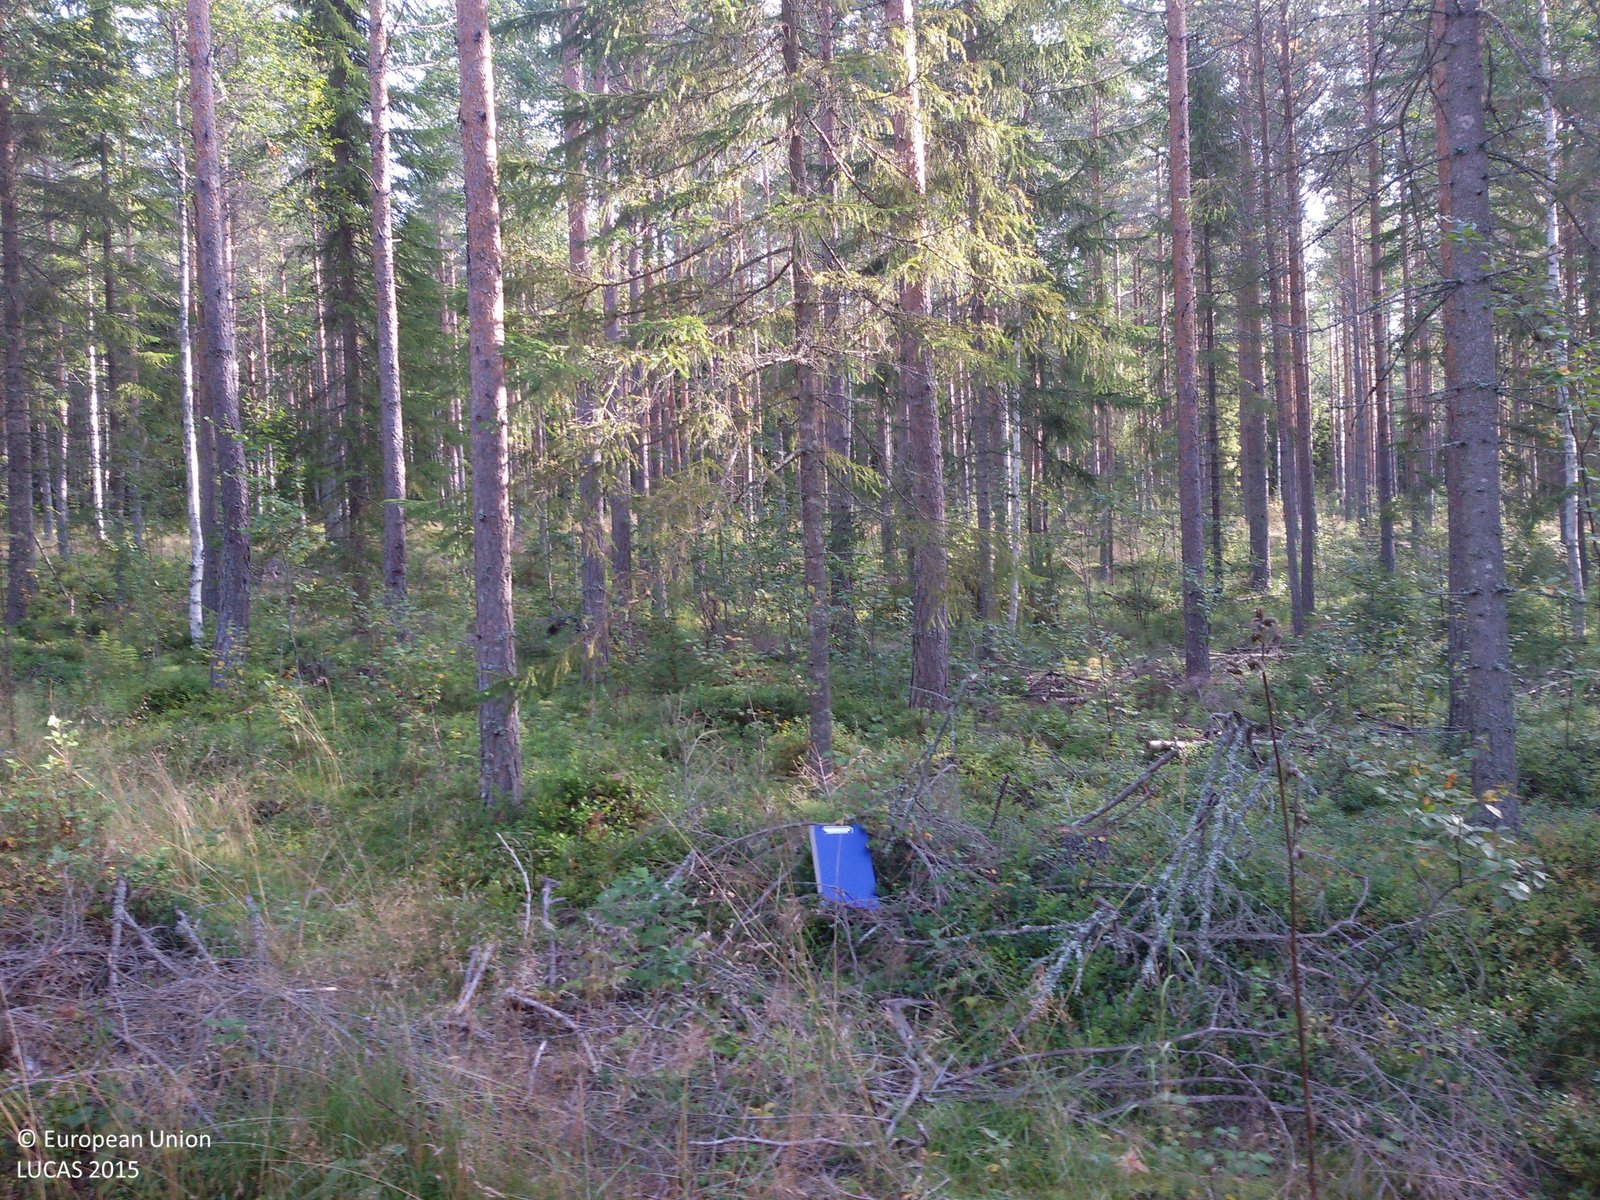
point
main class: Woodland
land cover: Pine dominated coniferous woodland
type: boreal forest
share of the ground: 50 - 75 %
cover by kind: coniferous forest trees 70 %, herbaceous plants 25 %, lichens and mosses 5 %
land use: Forestry
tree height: > 5 m
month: September
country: SE
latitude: 60.9573
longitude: 15.0275
